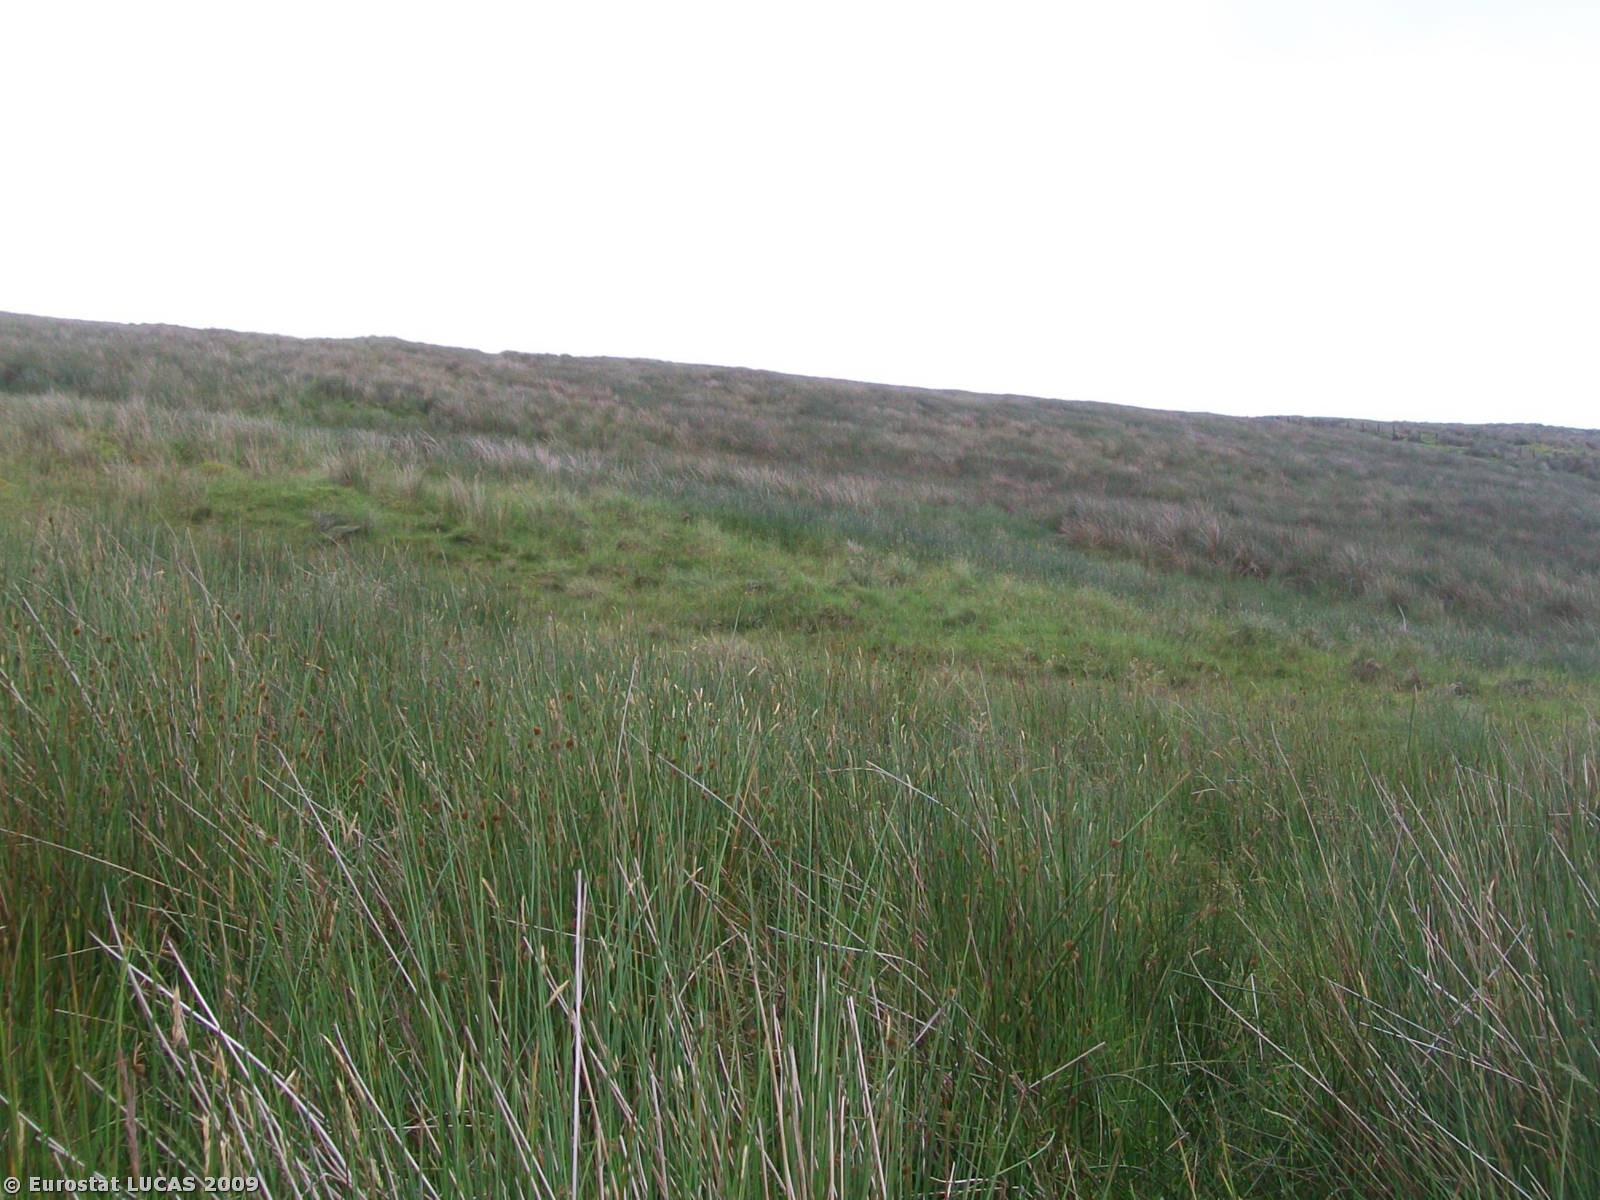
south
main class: Wetlands
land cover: Peatbogs
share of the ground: > 75 %
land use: Unused
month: July
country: GB
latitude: 54.7409
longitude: -6.7674
